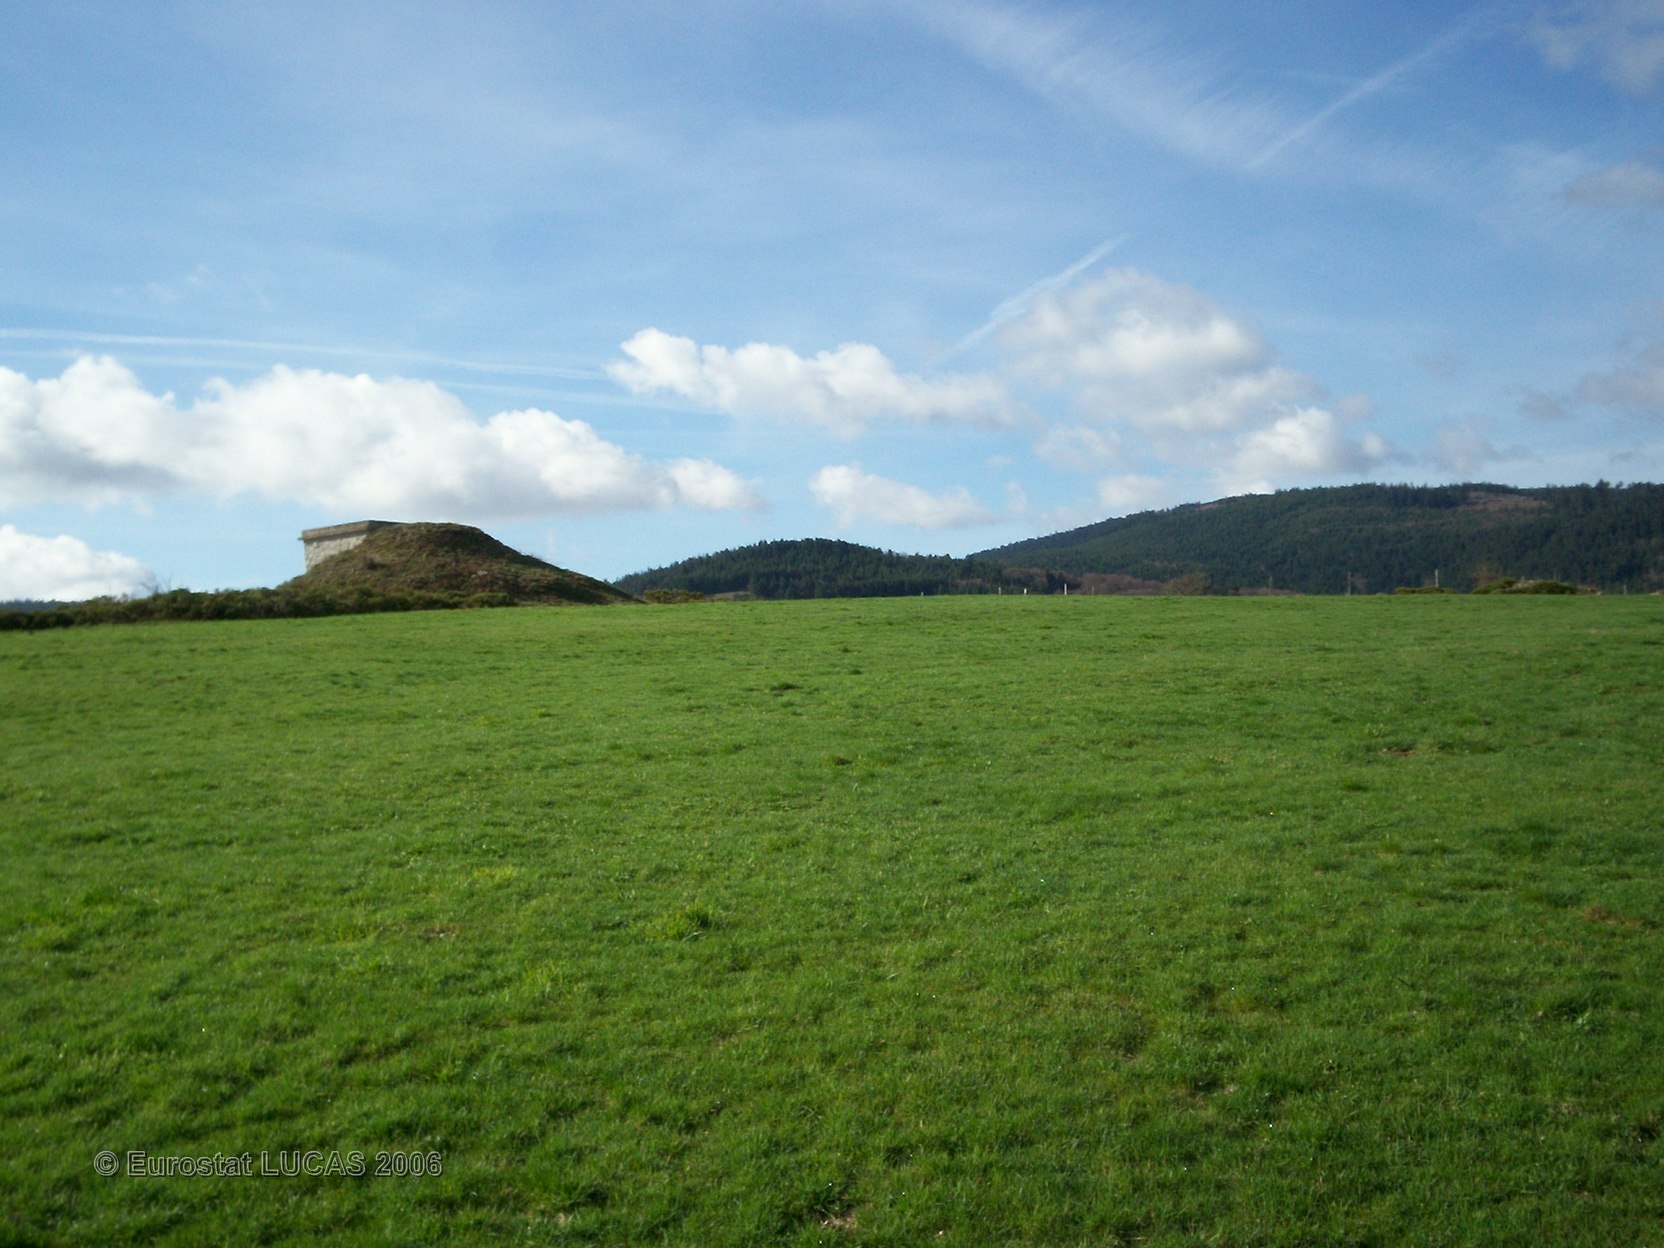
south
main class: Grassland
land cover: Grassland without tree/shrub cover
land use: Agriculture (excluding fallow land and kitchen gardens)
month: April
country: FR
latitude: 45.0603
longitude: 3.3612
